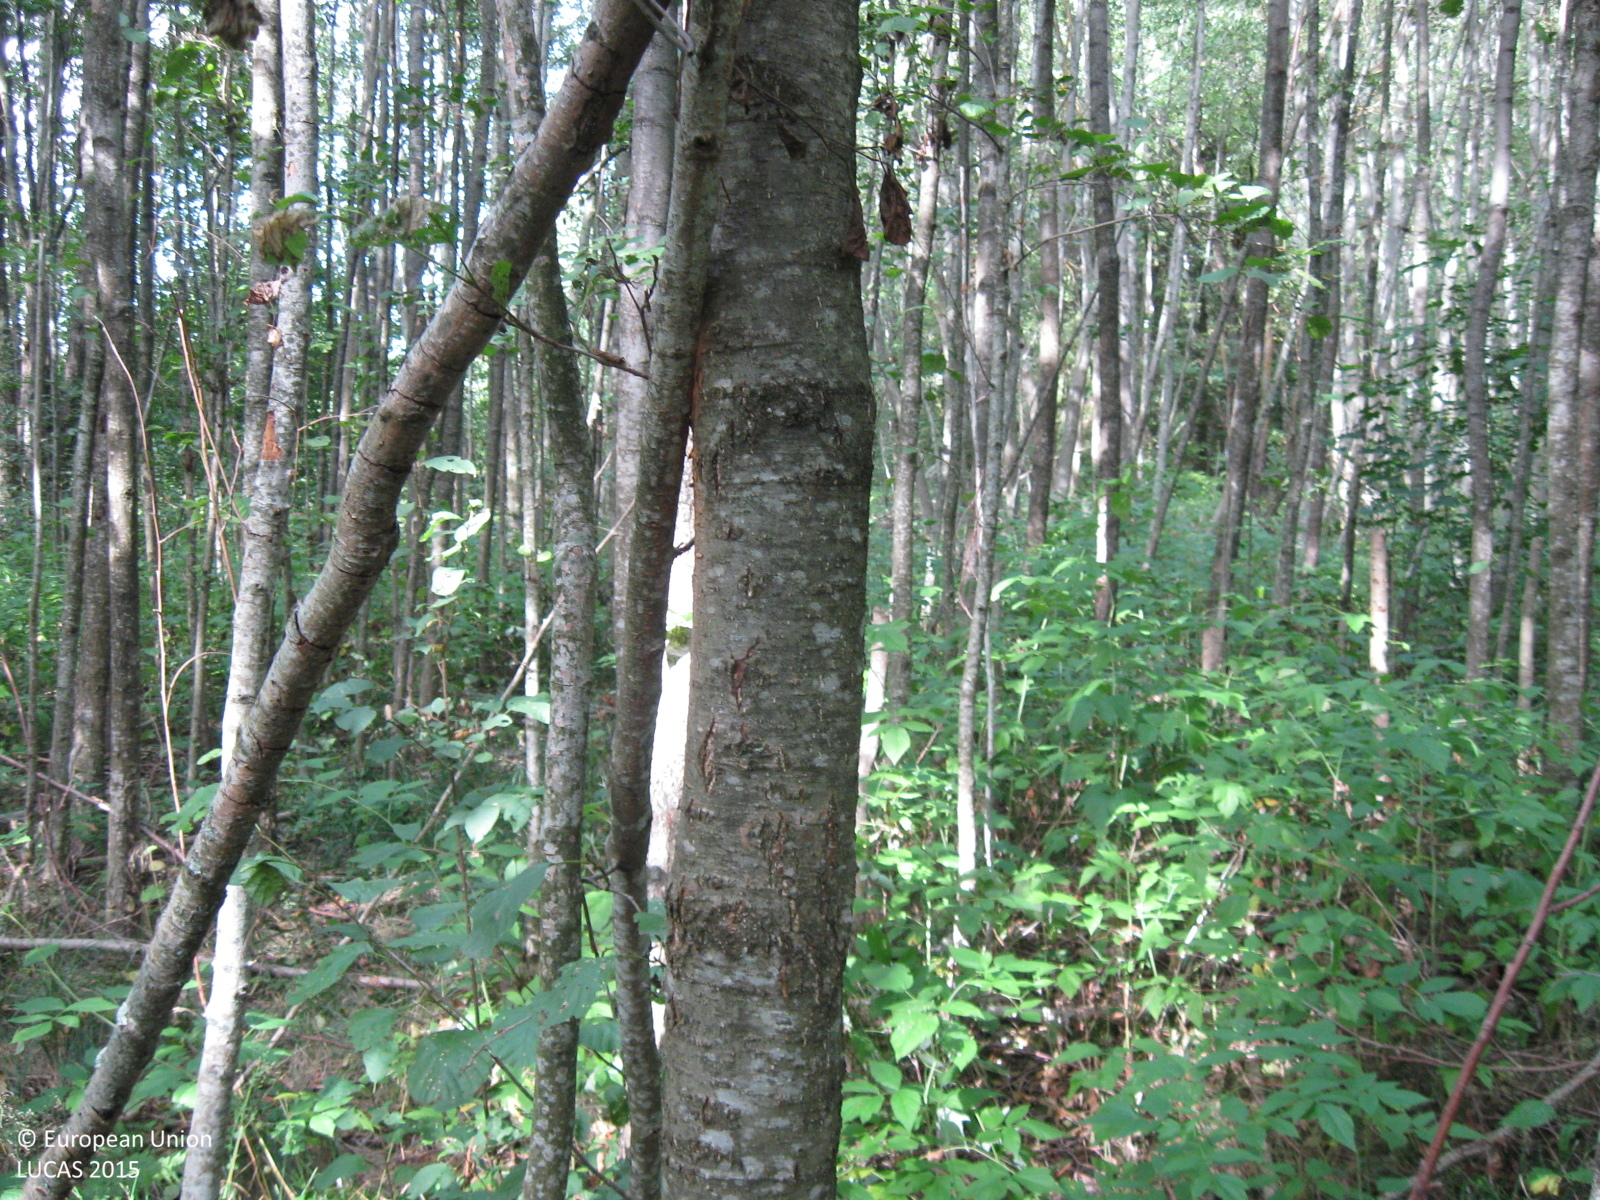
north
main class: Woodland
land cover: Broadleaved woodland
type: non-riverine alder, birch or aspen forest
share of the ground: > 75 %
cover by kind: broadleaved forest trees 90 %, shrubs 5 %, herbaceous plants 5 %
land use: Forestry
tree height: > 5 m
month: August
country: LT
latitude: 55.4185
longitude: 23.2984
